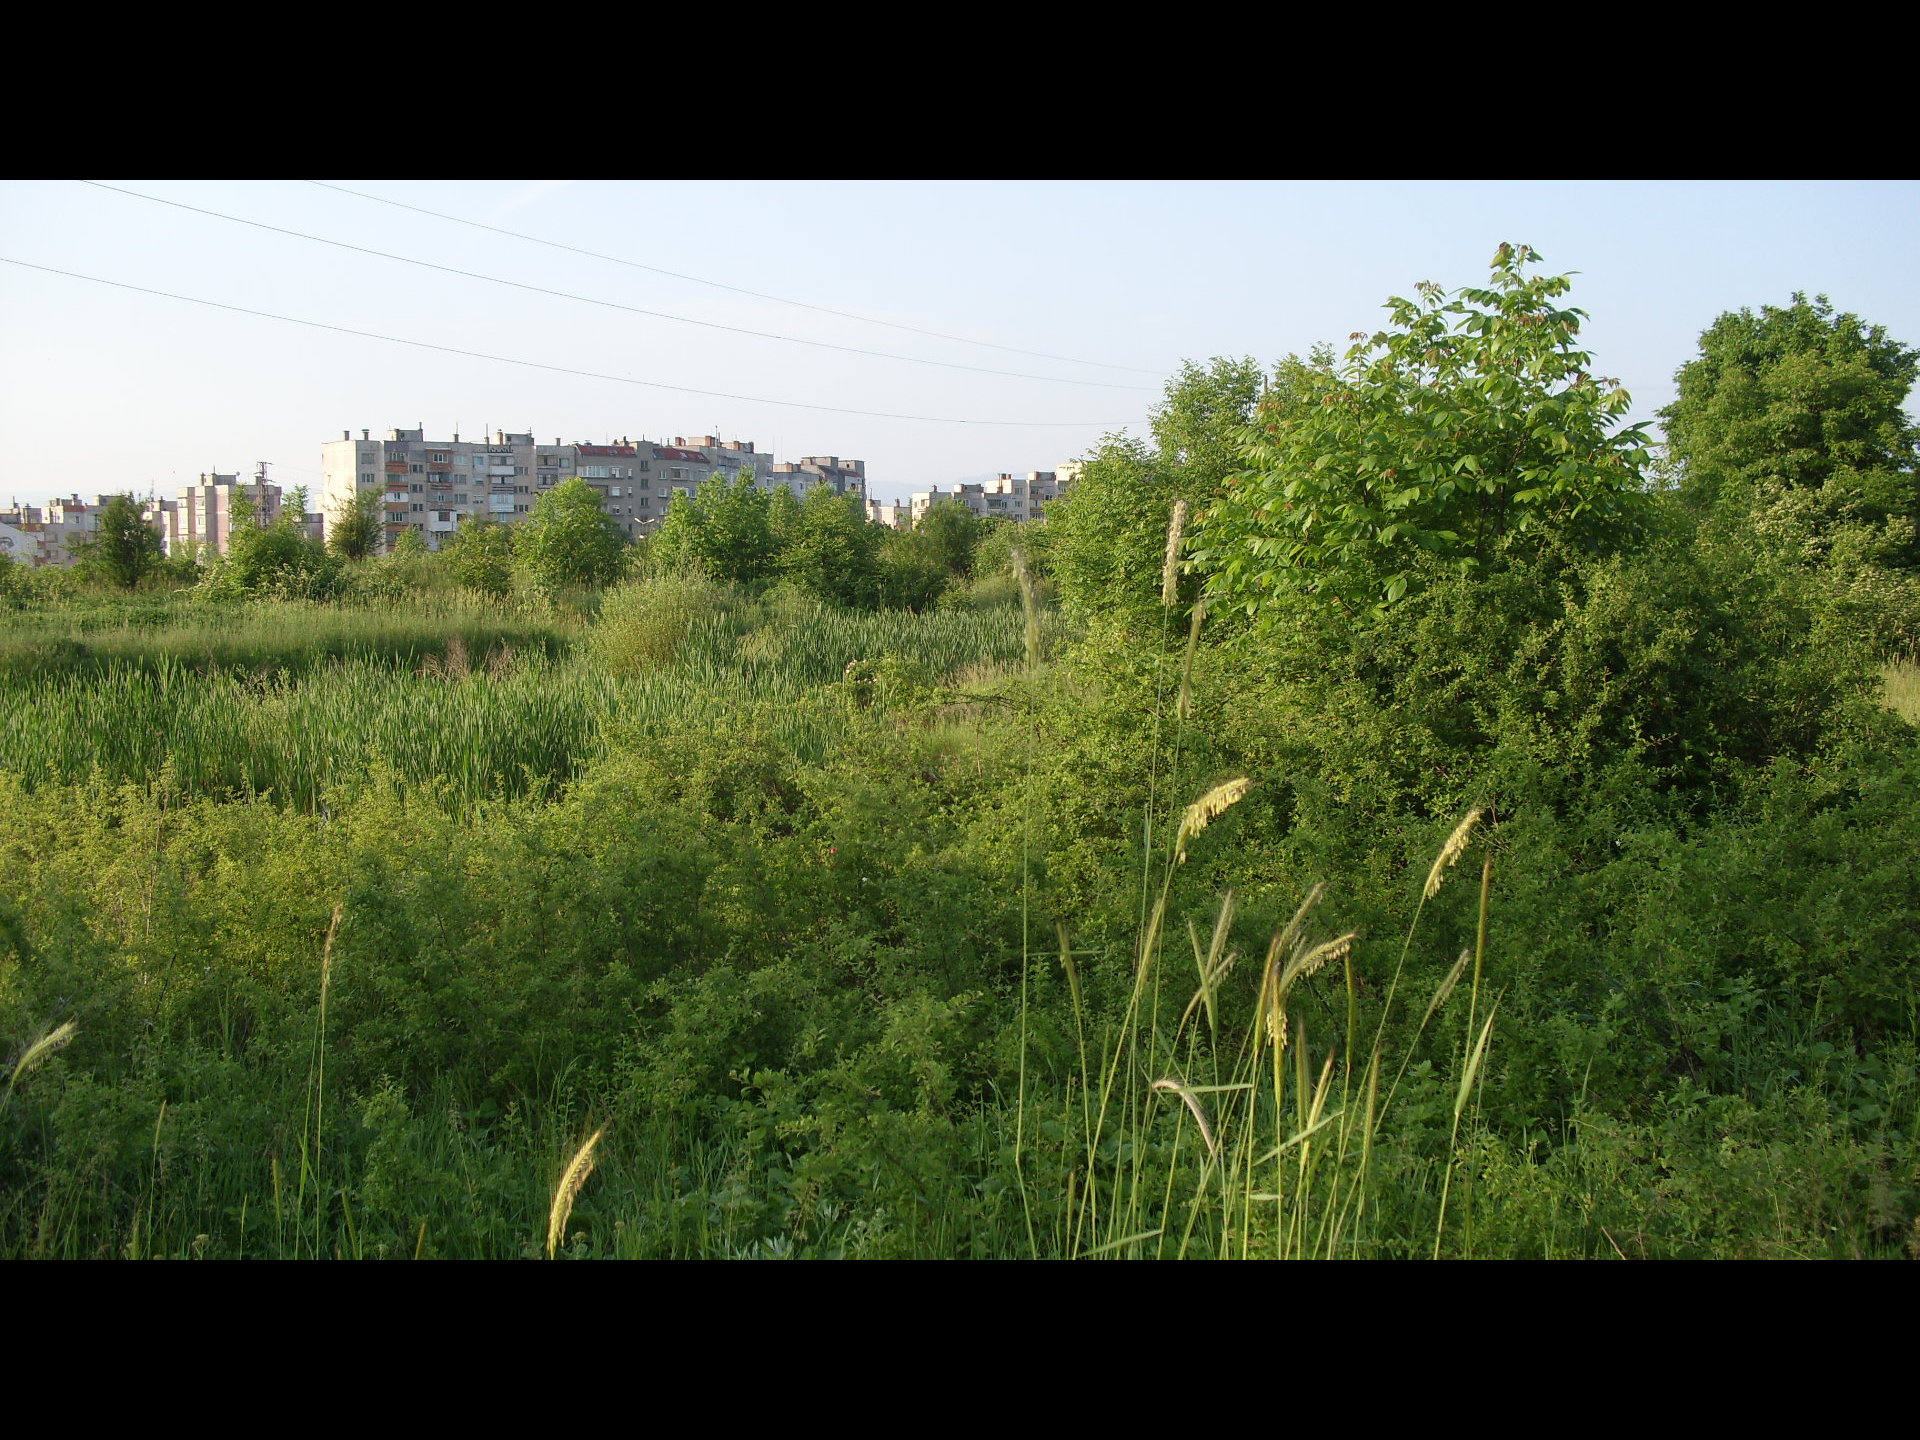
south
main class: Grassland
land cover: Grassland with sparse tree/shrub cover
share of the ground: > 75 %
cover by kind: herbaceous plants 90 %, broadleaved forest trees 5 %, shrubs 5 %
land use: Semi-natural and natural areas not in use
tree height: < 5 m
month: May
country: BG
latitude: 43.4275
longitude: 23.2201
